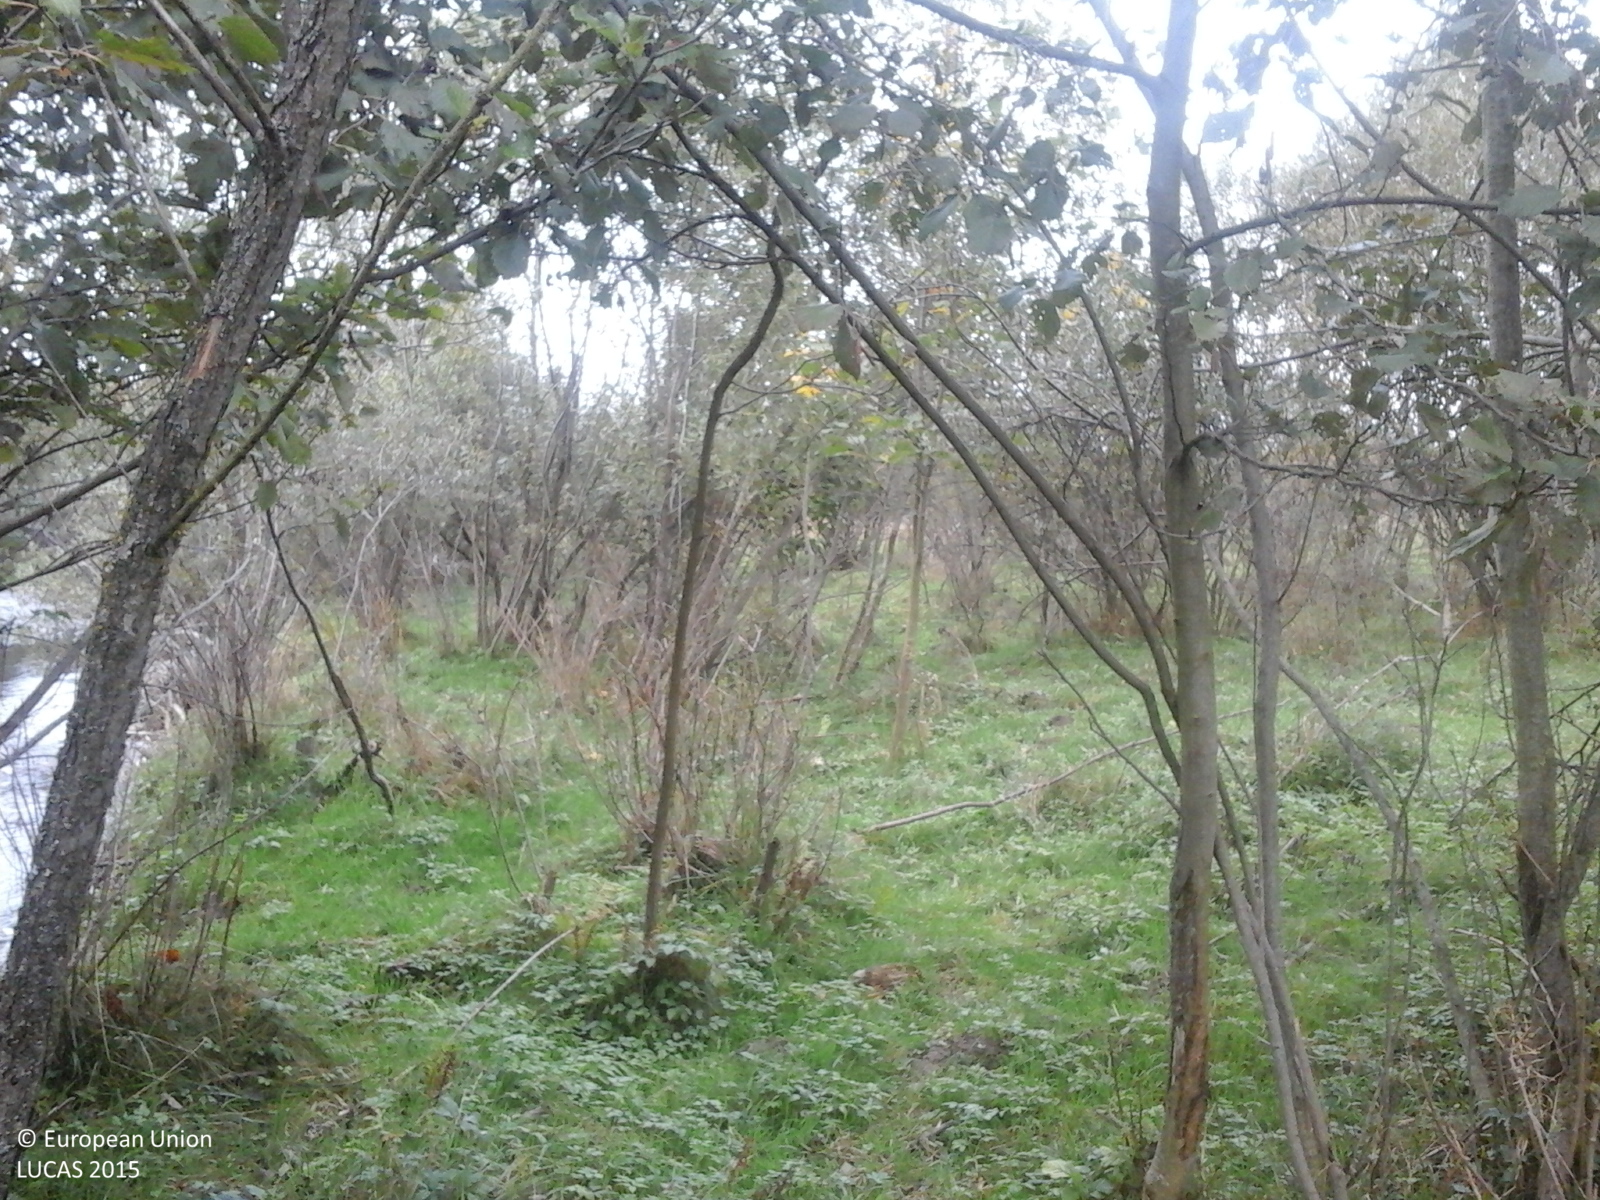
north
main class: Woodland
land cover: Other mixed woodland
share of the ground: > 75 %
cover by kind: broadleaved forest trees 65 %, coniferous forest trees 25 %, herbaceous plants 10 %
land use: Forestry
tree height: < 5 m
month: October
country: RO
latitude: 45.7140
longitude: 24.8225
